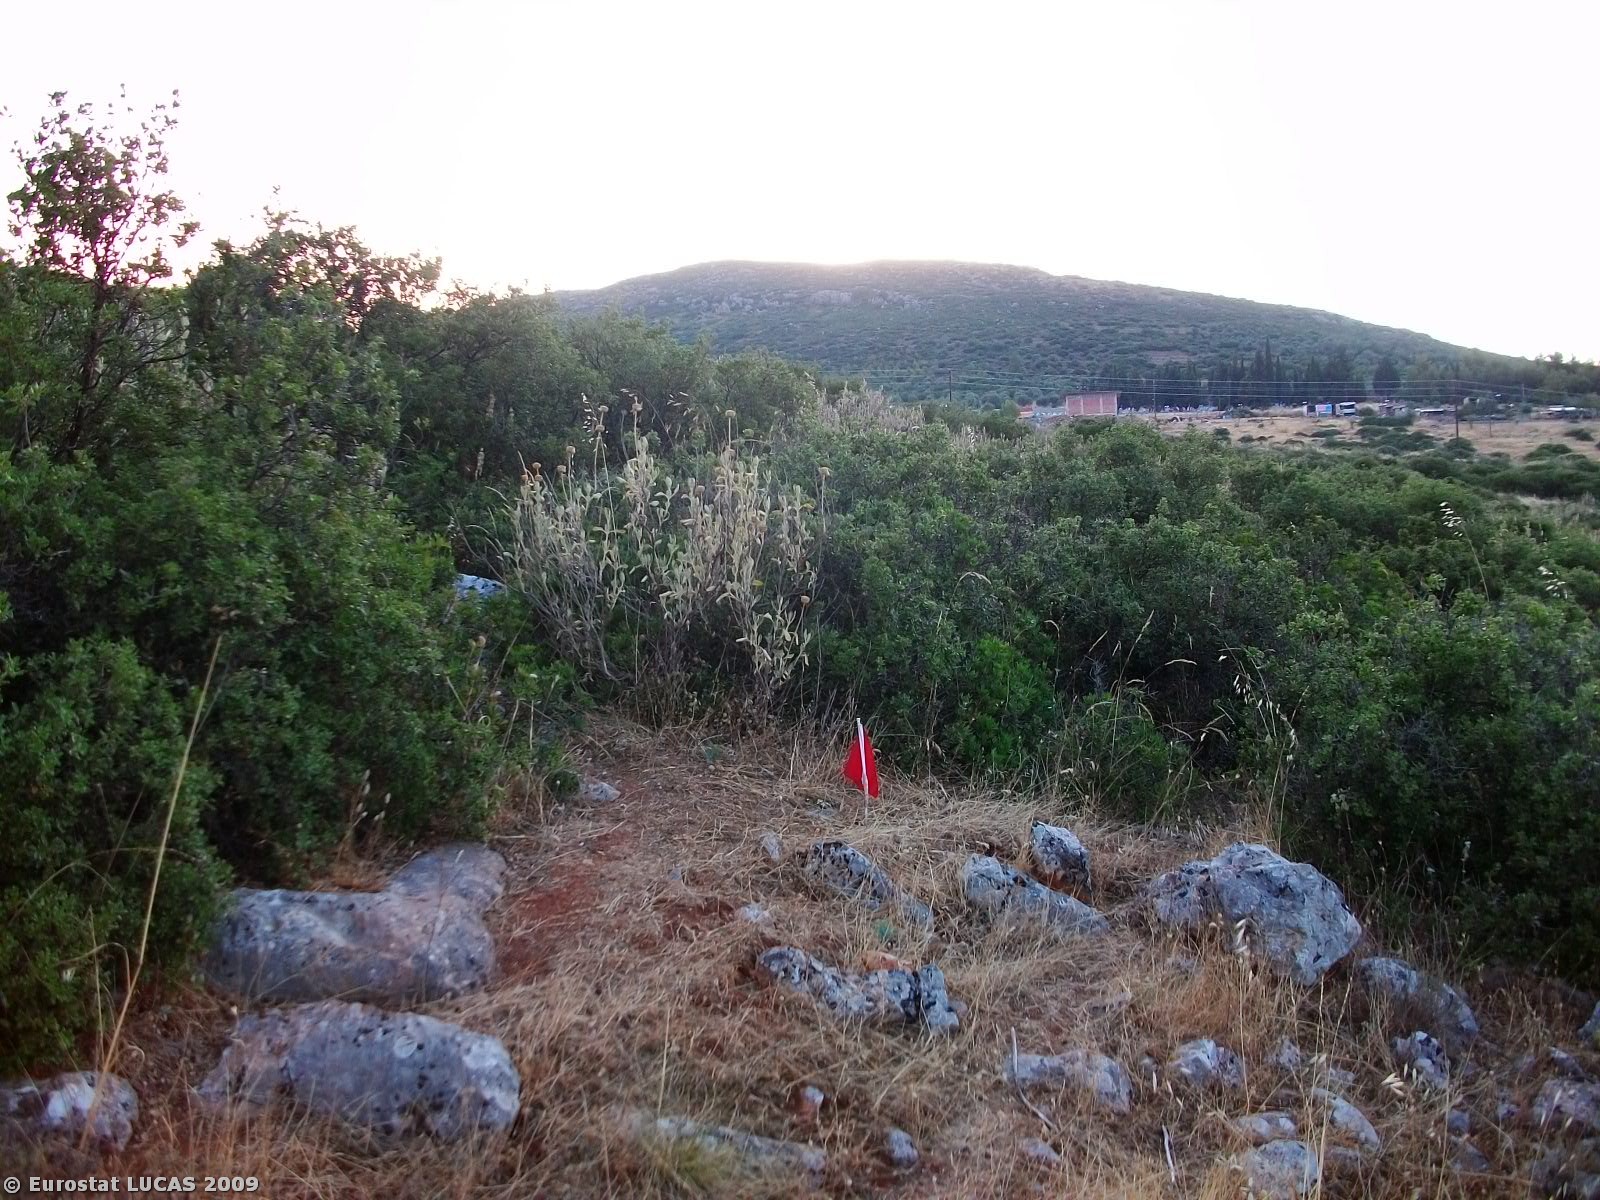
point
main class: Shrubland
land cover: Shrubland without tree cover
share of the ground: > 75 %
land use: Agriculture (excluding fallow land and kitchen gardens)
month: June
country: GR
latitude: 38.5251
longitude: 23.0923
